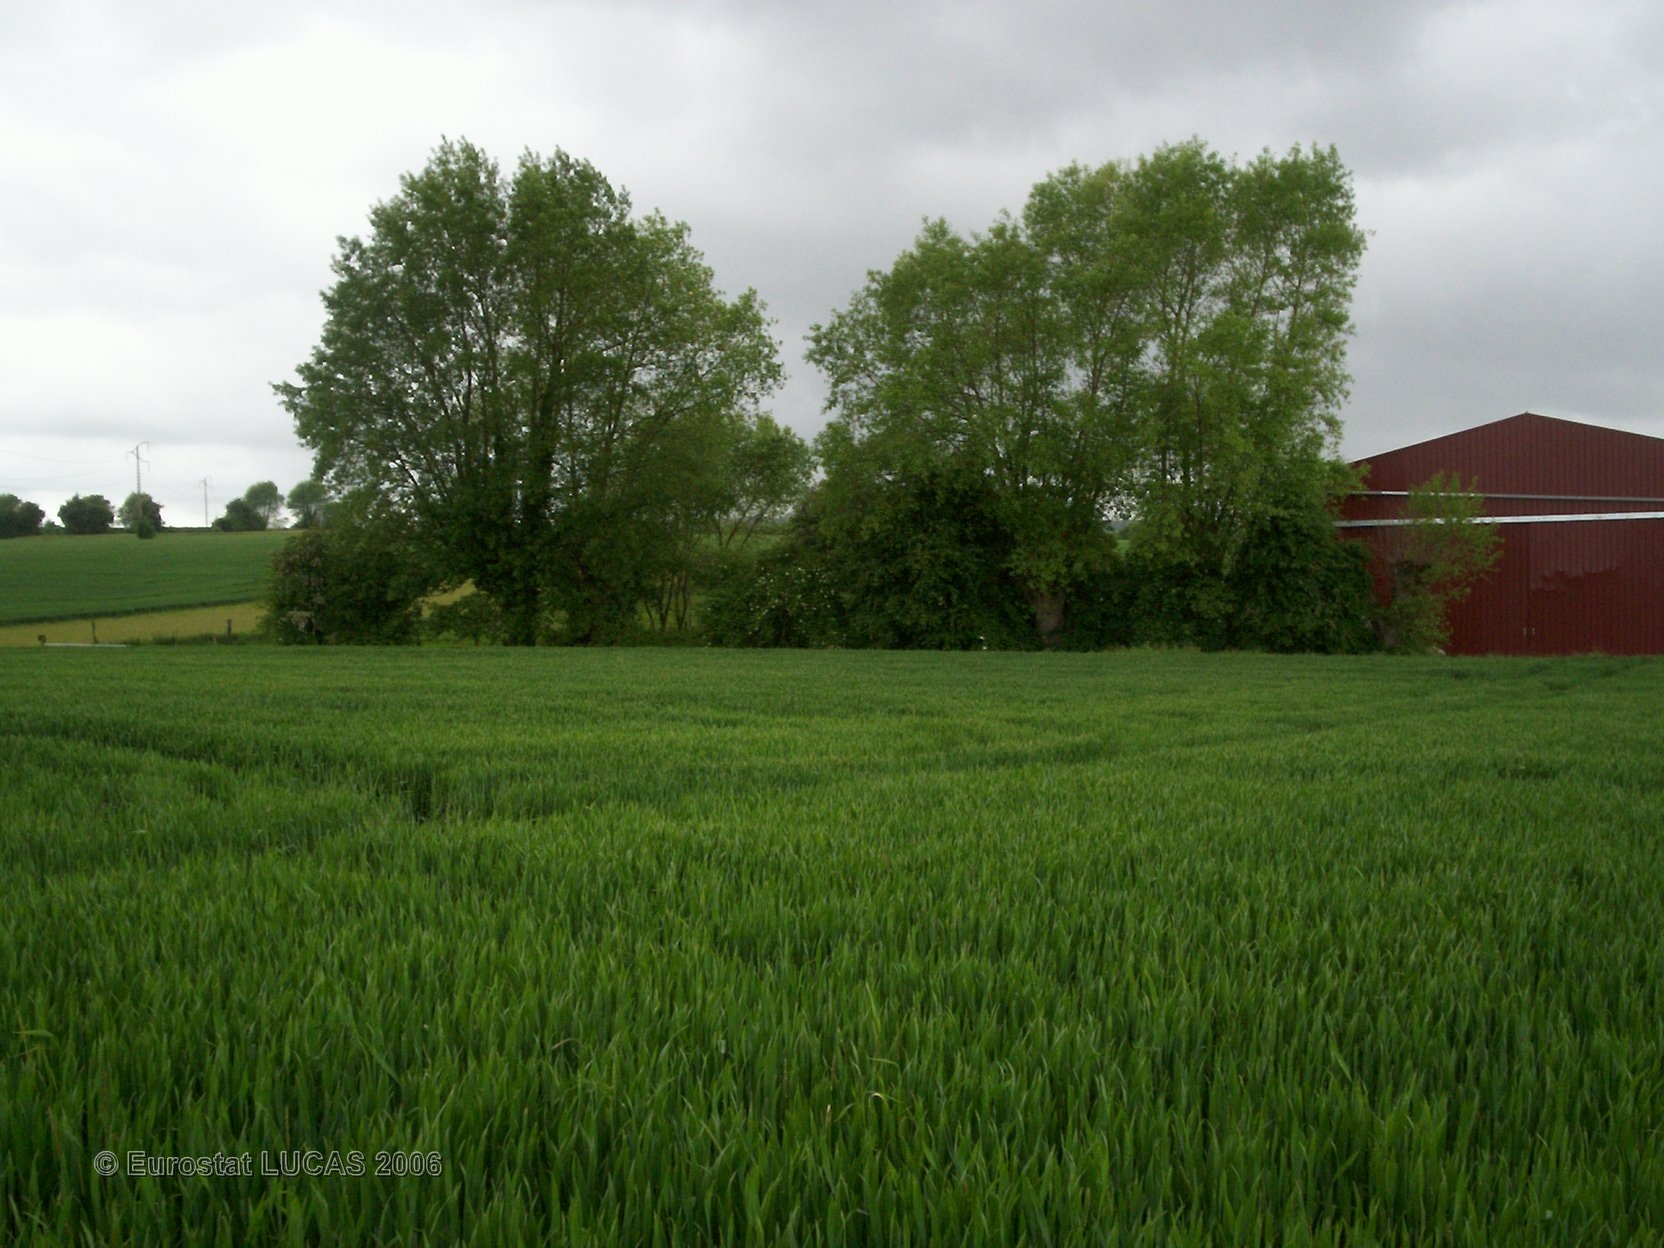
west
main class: Cropland
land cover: Common wheat
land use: Agriculture (excluding fallow land and kitchen gardens)
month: May
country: FR
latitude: 50.4452
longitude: 2.5382
